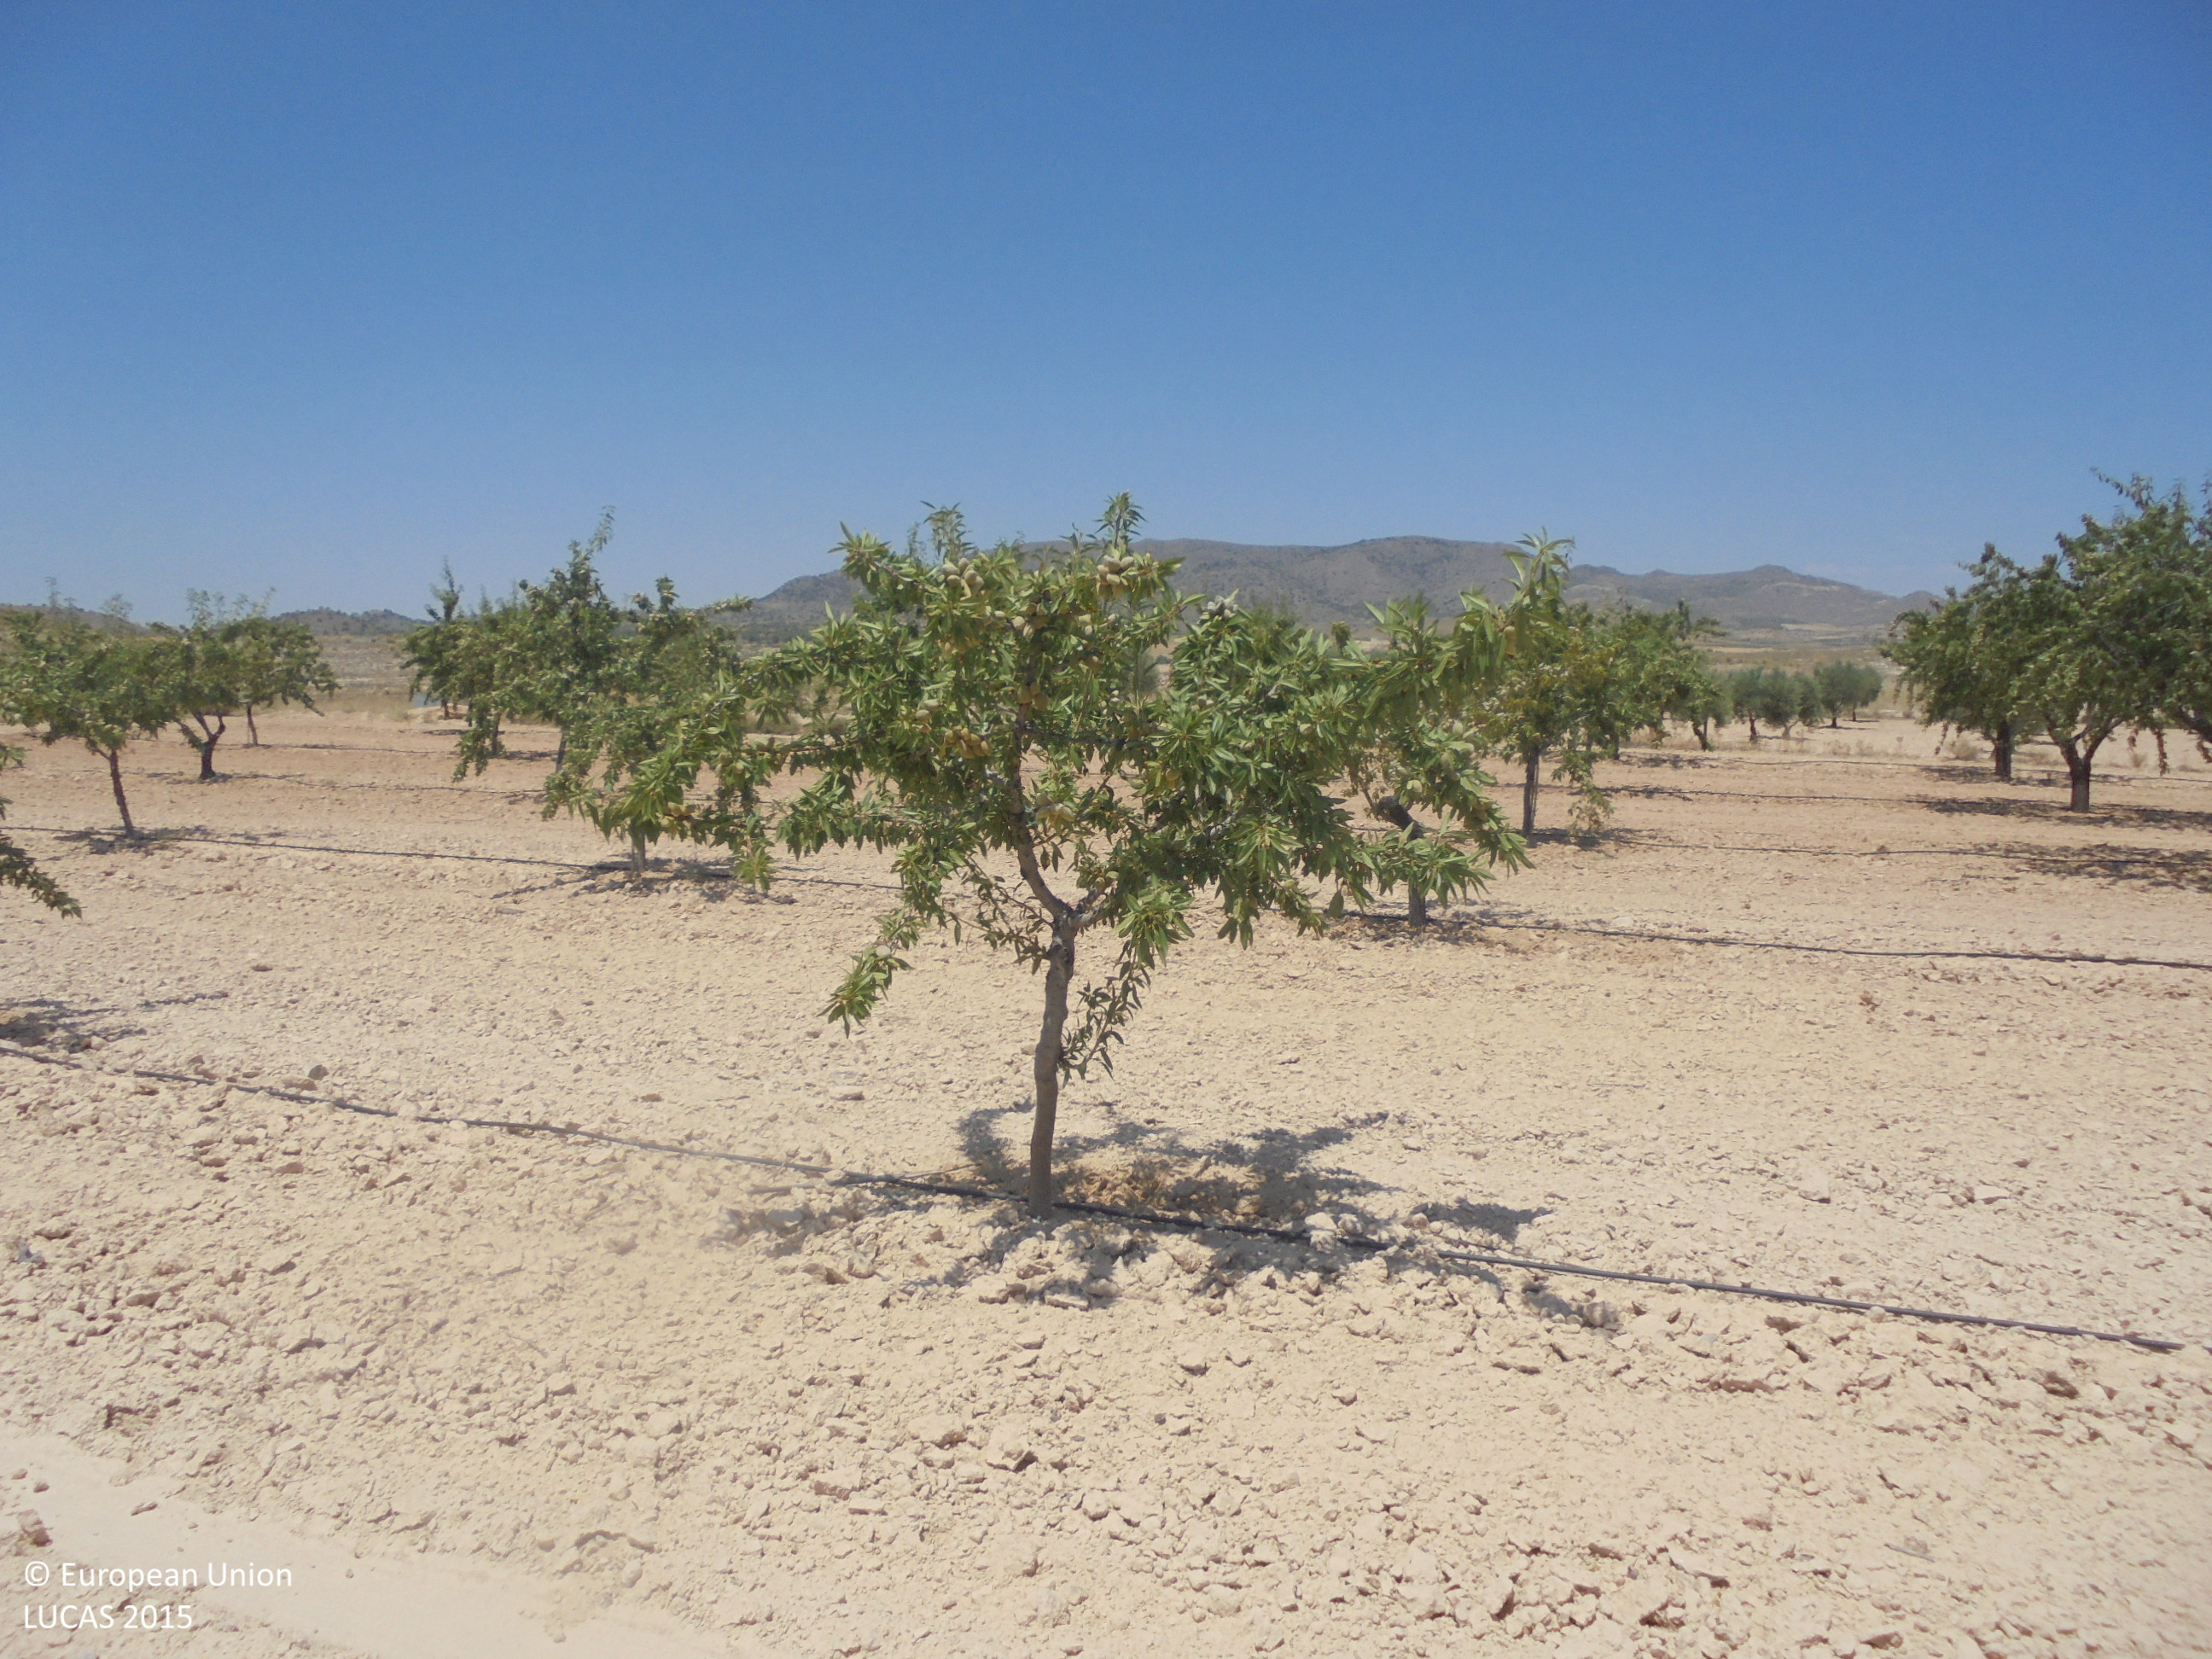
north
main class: Cropland
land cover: Nuts trees
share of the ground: 10 - 25 %
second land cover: Other bare soil
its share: > 75 %
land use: Agriculture (excluding fallow land and kitchen gardens)
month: July
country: ES
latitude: 38.5982
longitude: -1.5328
